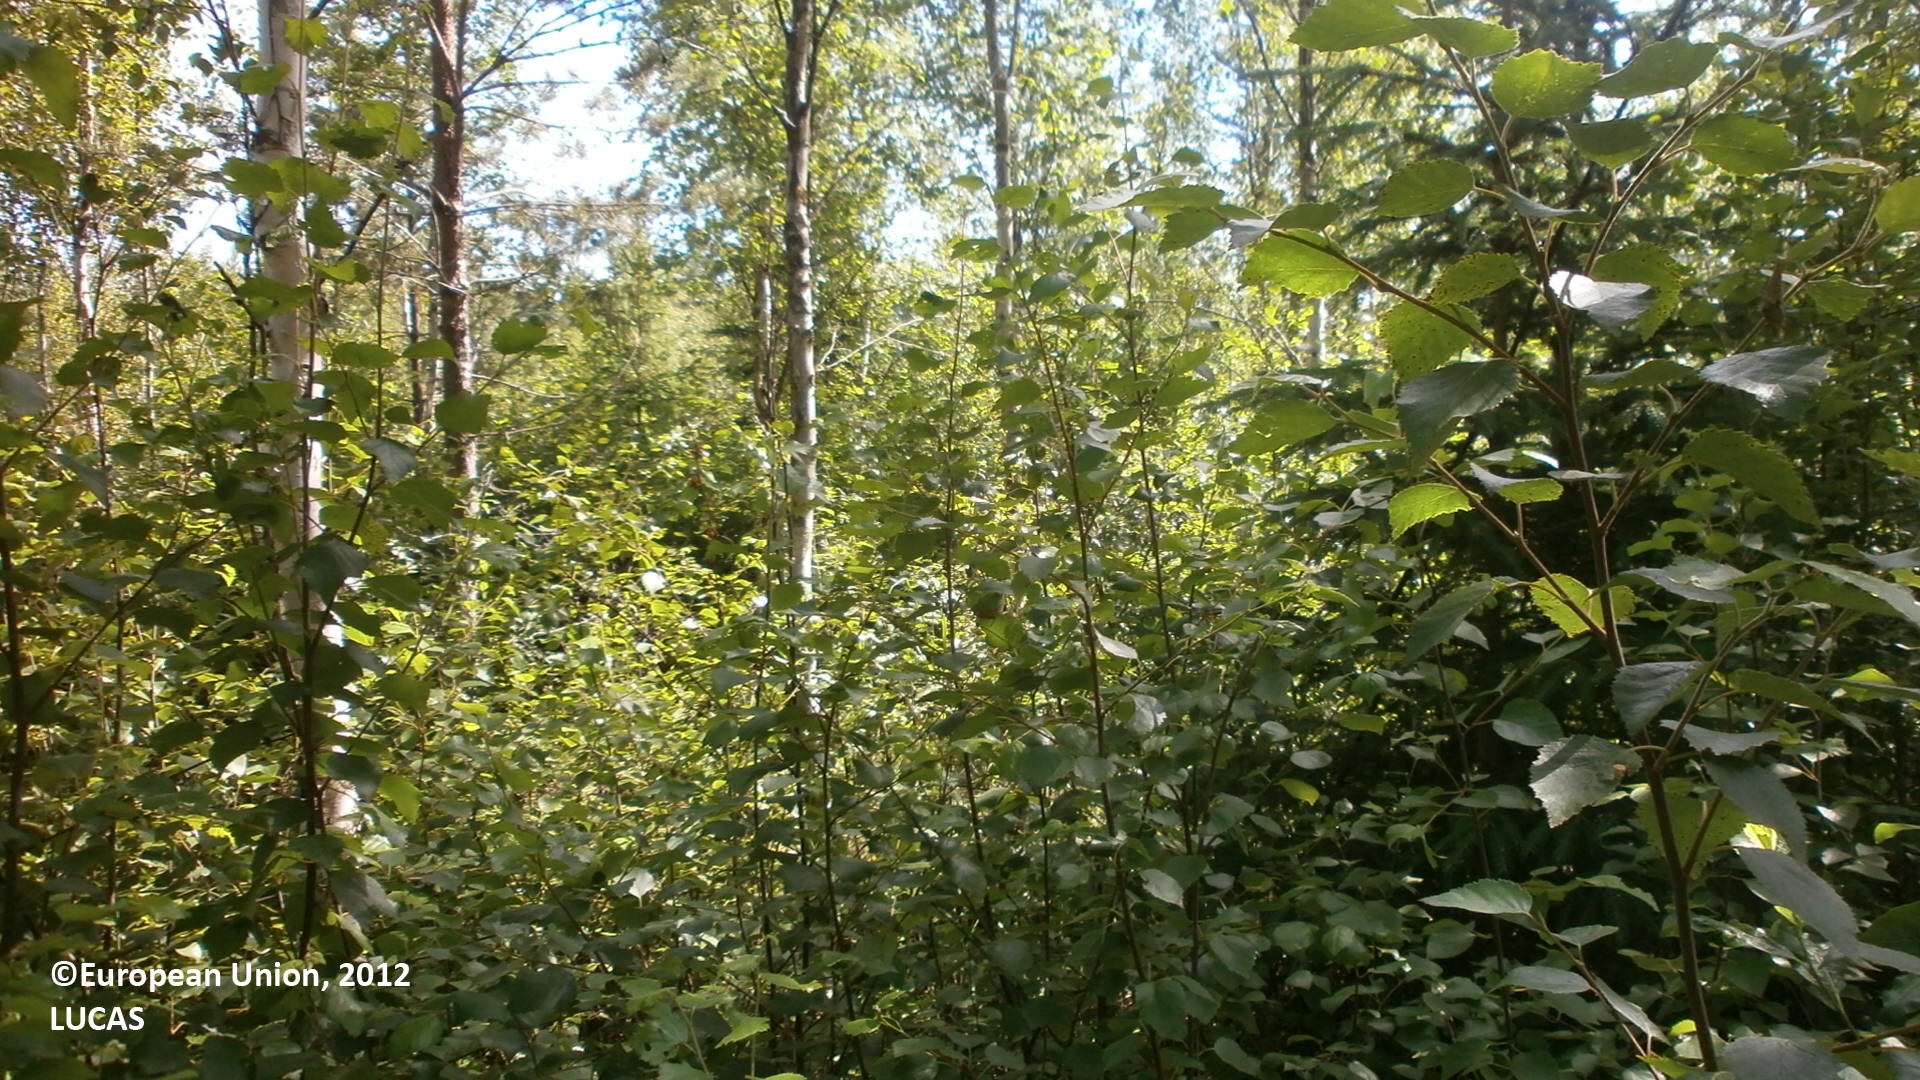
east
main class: Woodland
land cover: Other mixed woodland
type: boreal forest
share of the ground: > 75 %
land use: Forestry
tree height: > 5 m
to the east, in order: Other mixed woodland; Ditches and canals; Shruby margins; Tracks; Pine dominated mixed woodland; Ditches and canals; Spruce dominated coniferous woodland; Ditches and canals; Pine dominated coniferous woodland; Spruce dominated mixed woodland; Broadleaved woodland; Ditches and canals; Broadleaved woodland; Spruce dominated coniferous woodland
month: July
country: FI
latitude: 64.3126
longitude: 24.1458
